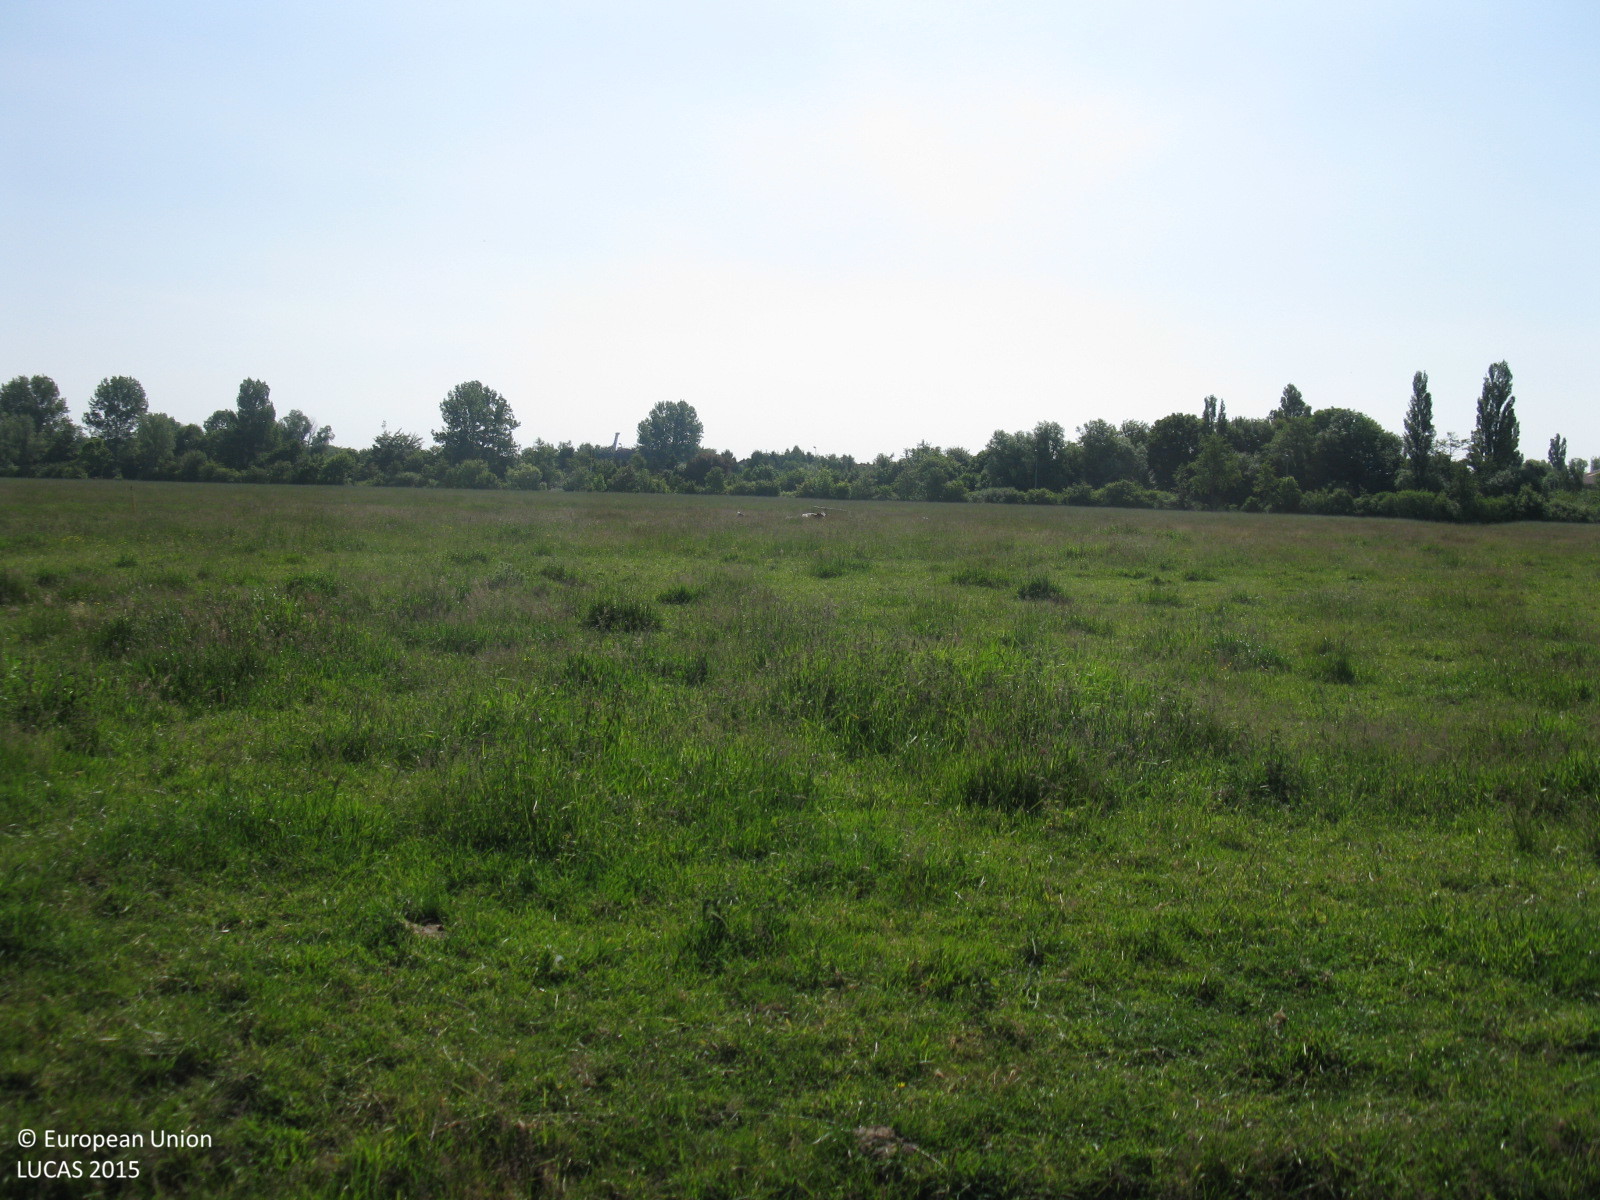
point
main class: Grassland
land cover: Grassland without tree/shrub cover
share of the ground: > 75 %
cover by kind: herbaceous plants 100 %
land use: Agriculture (excluding fallow land and kitchen gardens)
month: June
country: DE
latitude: 53.5186
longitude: 8.5075
